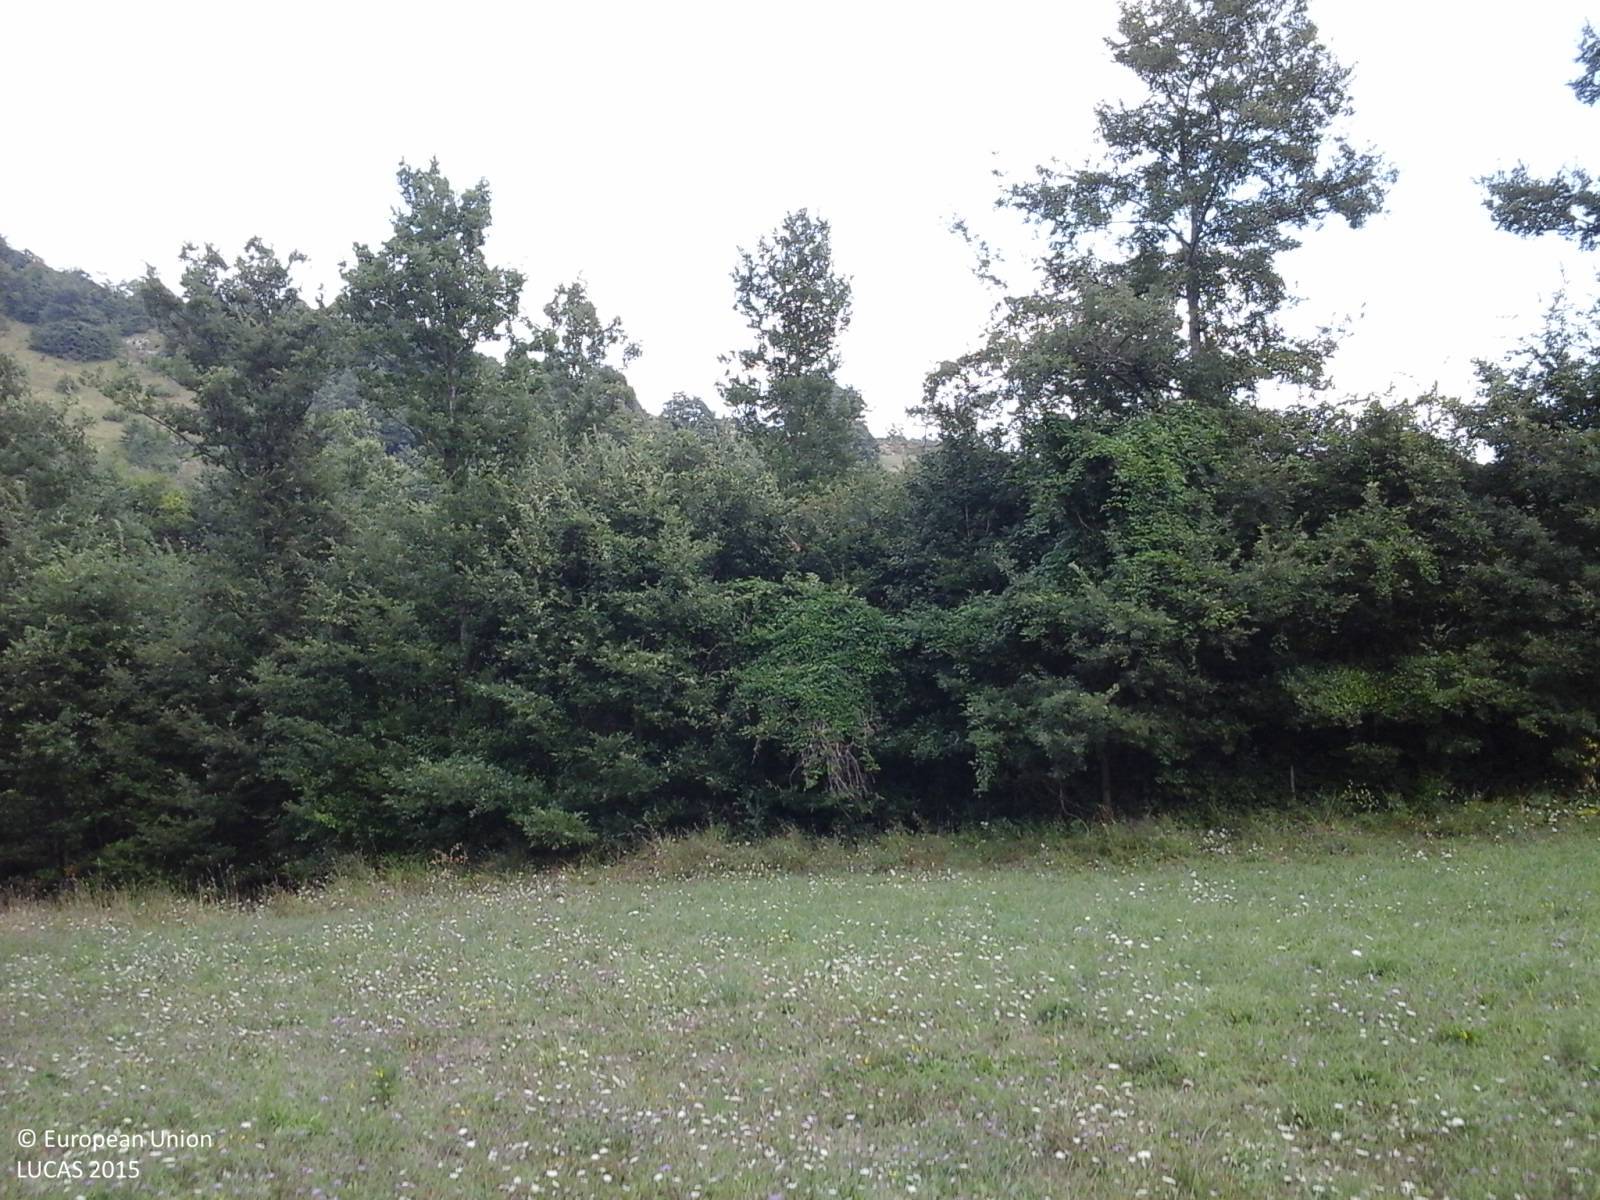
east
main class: Grassland
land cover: Grassland without tree/shrub cover
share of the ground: > 75 %
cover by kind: herbaceous plants 100 %
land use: Agriculture (excluding fallow land and kitchen gardens)
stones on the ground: < 10 %
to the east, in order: Grassland without tree/shrub cover; Broadleaved woodland; Inland fresh running water; Broadleaved woodland; Tracks; Broadleaved woodland; Artificial constructions in urban areas; Broadleaved woodland; Grassland without tree/shrub cover
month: August
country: IT
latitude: 43.7154
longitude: 12.1170
